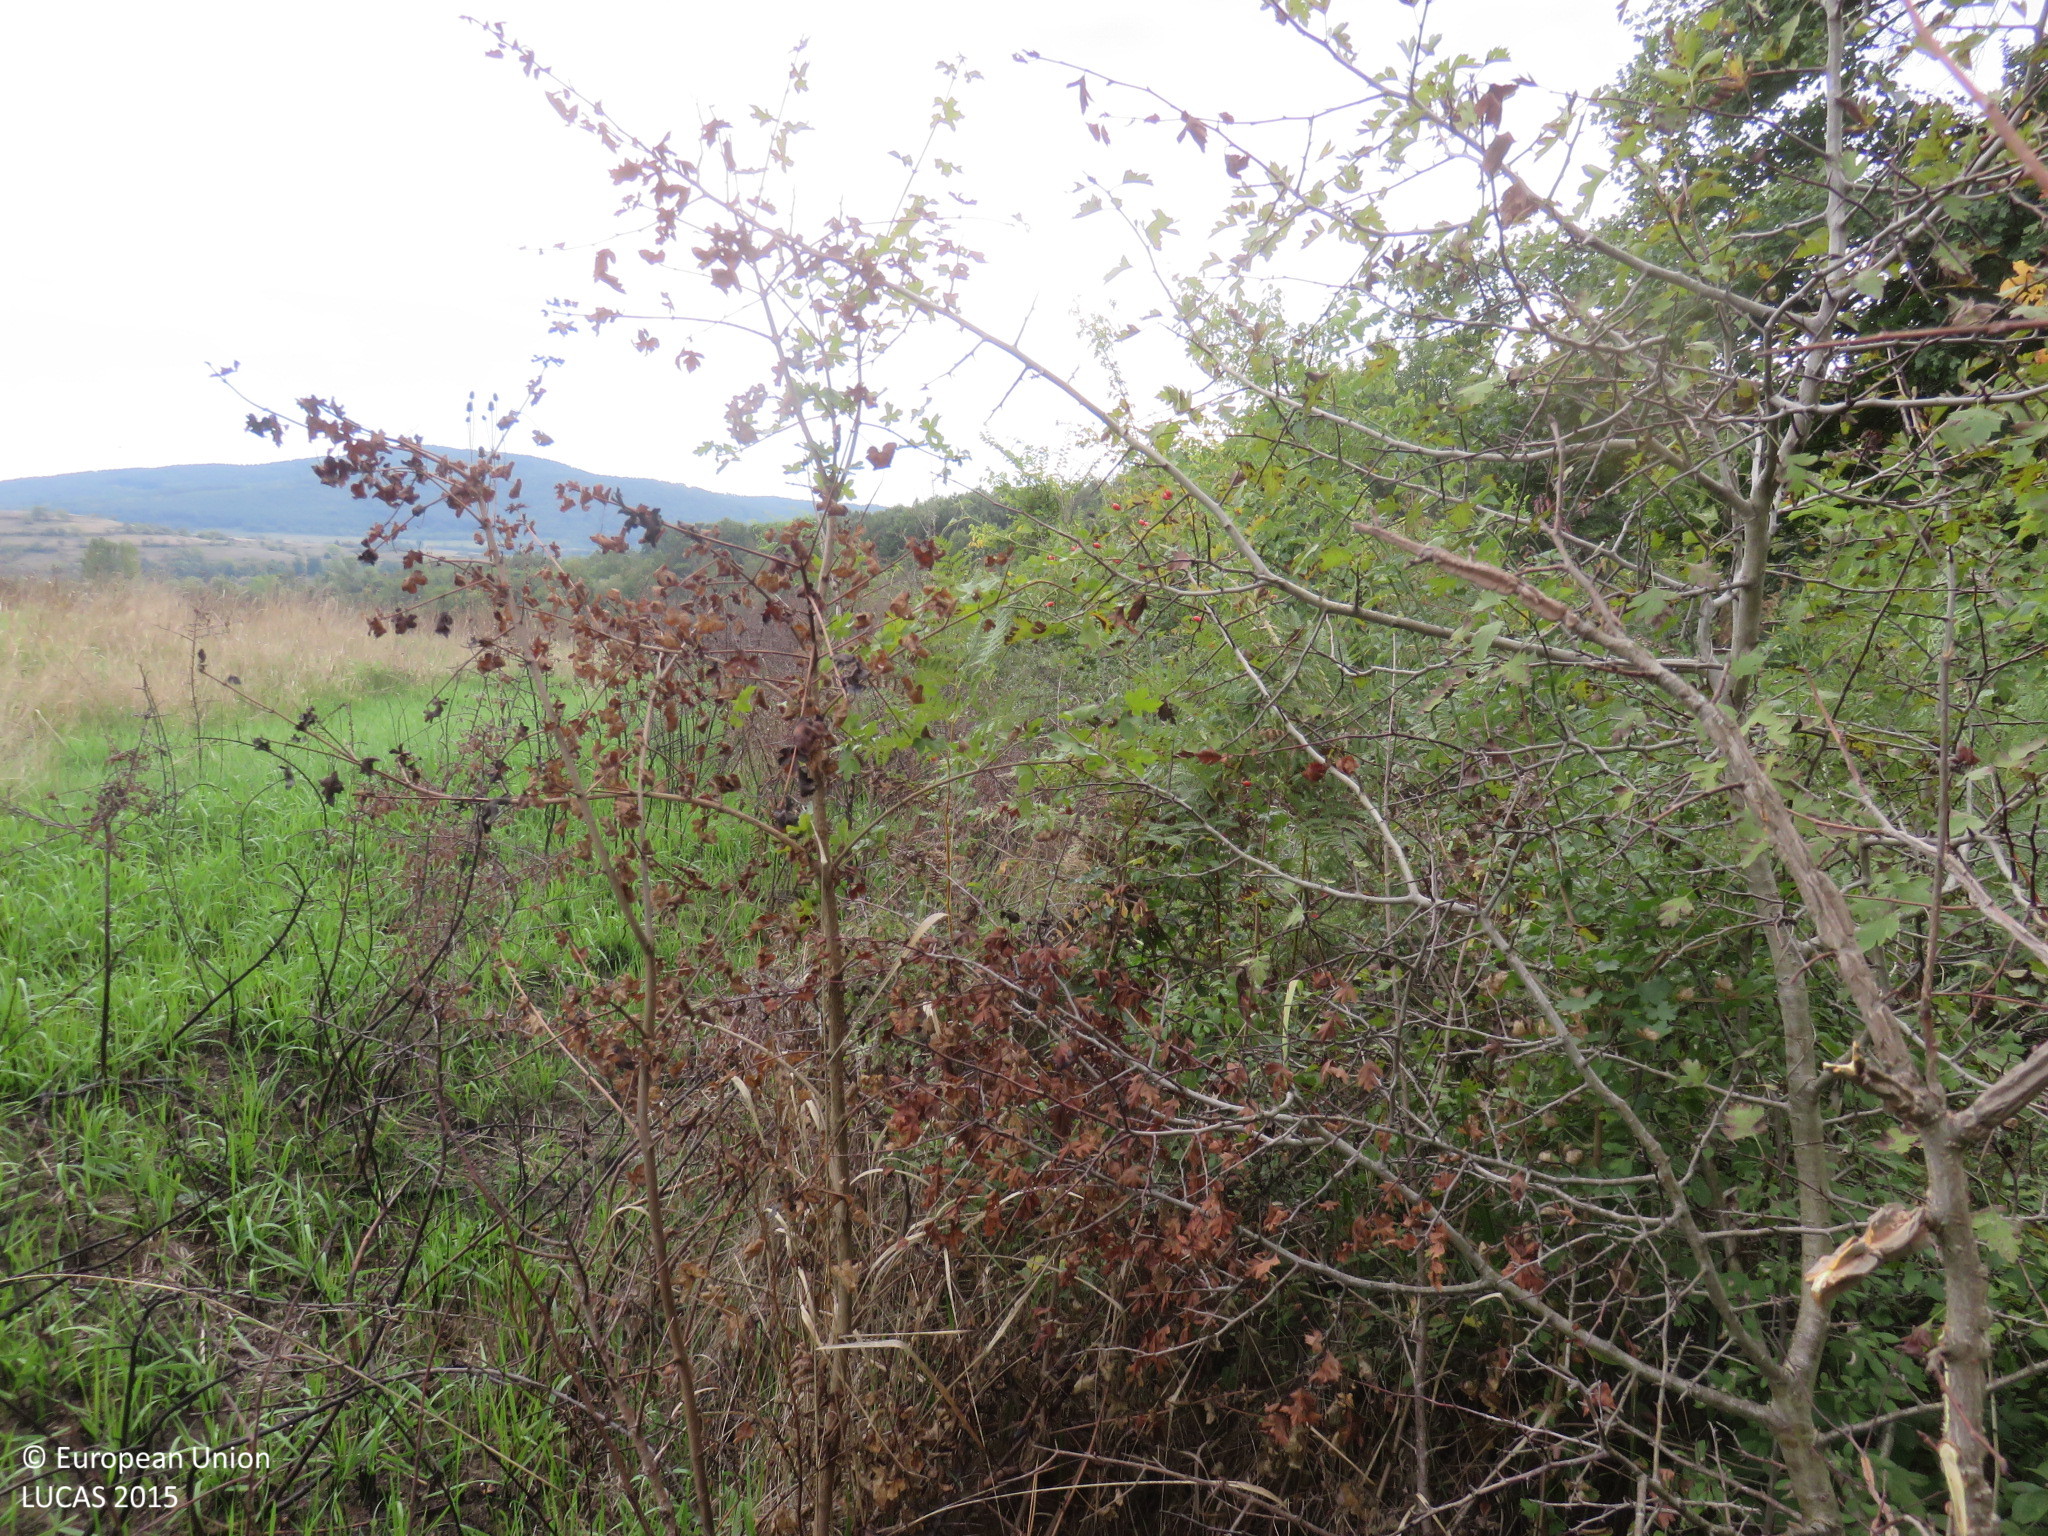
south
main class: Shrubland
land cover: Shrubland with sparse tree cover
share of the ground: > 75 %
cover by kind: shrubs 90 %, broadleaved forest trees 5 %, herbaceous plants 5 %
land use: Semi-natural and natural areas not in use
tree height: < 5 m
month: October
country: BG
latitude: 43.0540
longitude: 24.8581
